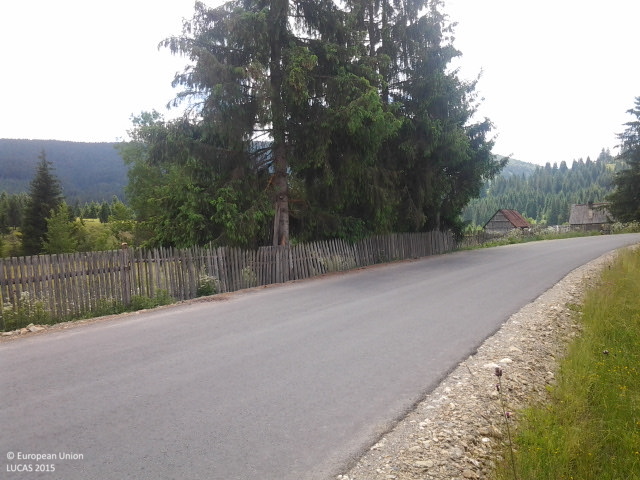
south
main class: Grassland
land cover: Grassland without tree/shrub cover
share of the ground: > 75 %
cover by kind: herbaceous plants 100 %
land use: Agriculture (excluding fallow land and kitchen gardens)
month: June
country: RO
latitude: 46.9926
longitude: 25.4837
